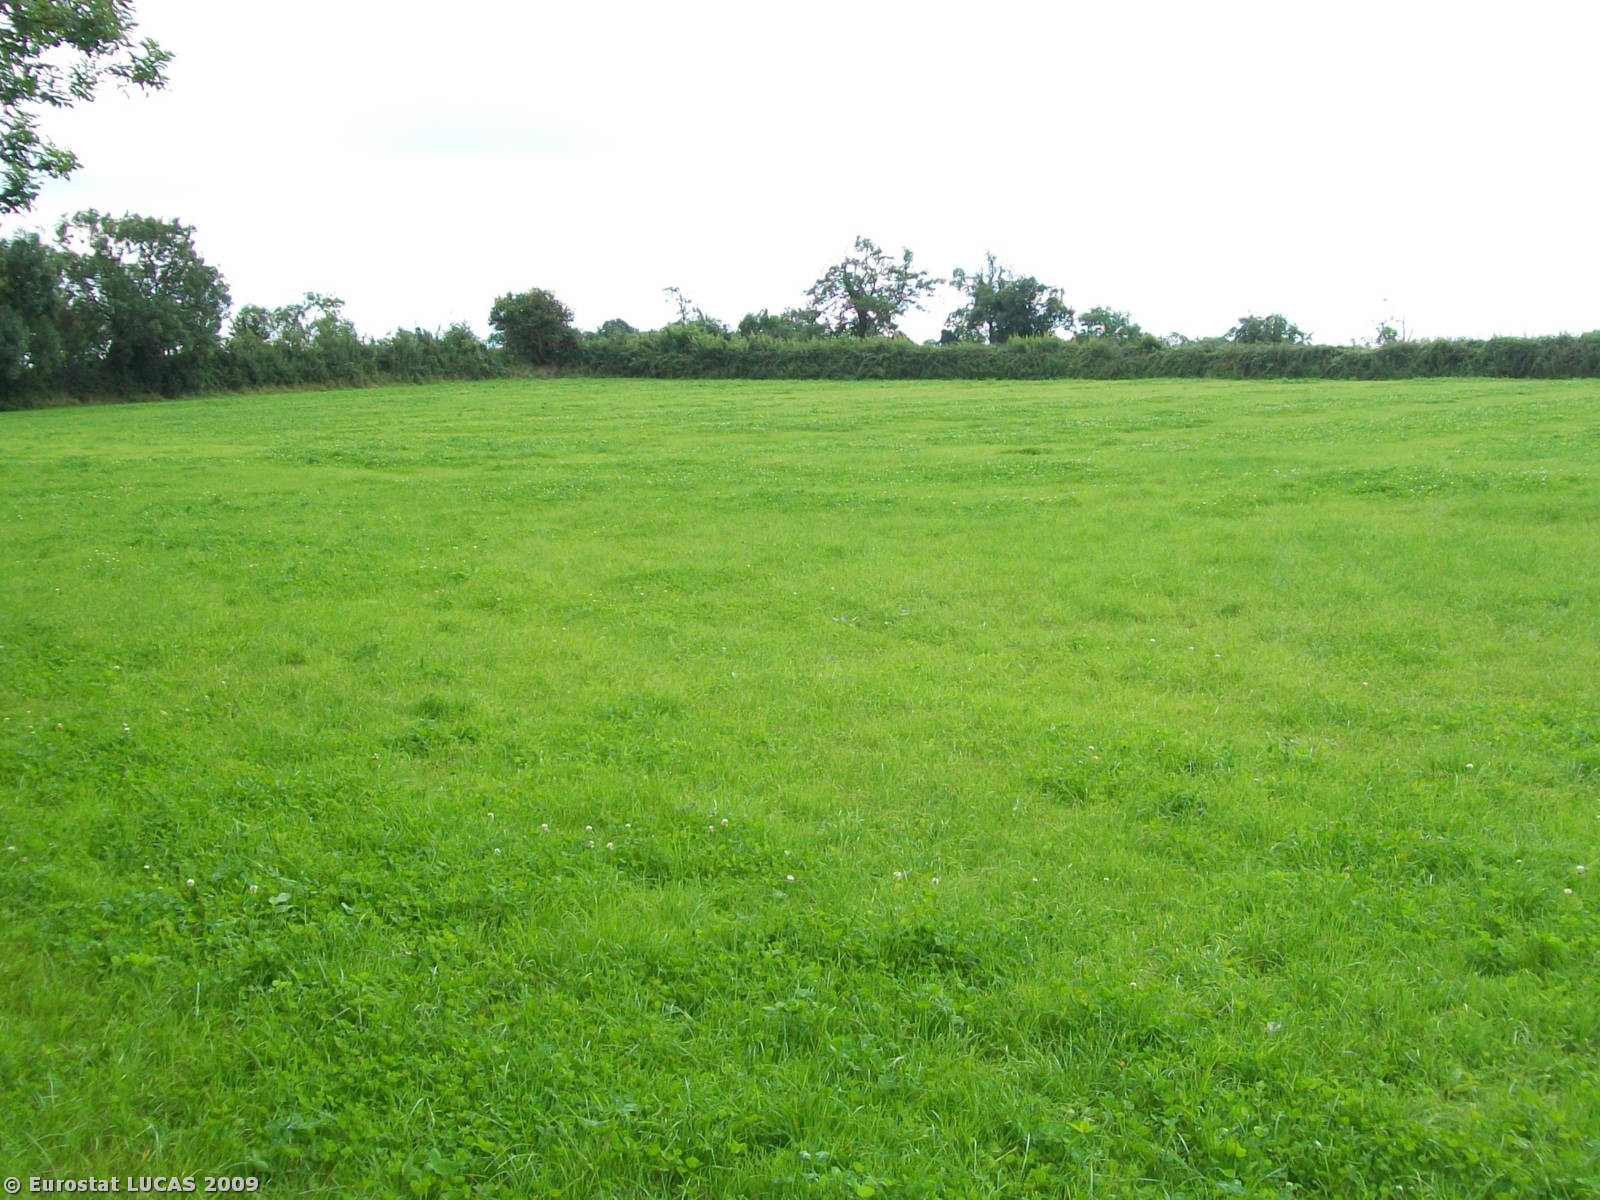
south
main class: Grassland
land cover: Grassland without tree/shrub cover
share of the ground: > 75 %
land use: Agriculture (excluding fallow land and kitchen gardens)
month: August
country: GB
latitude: 51.7965
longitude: -2.4044
